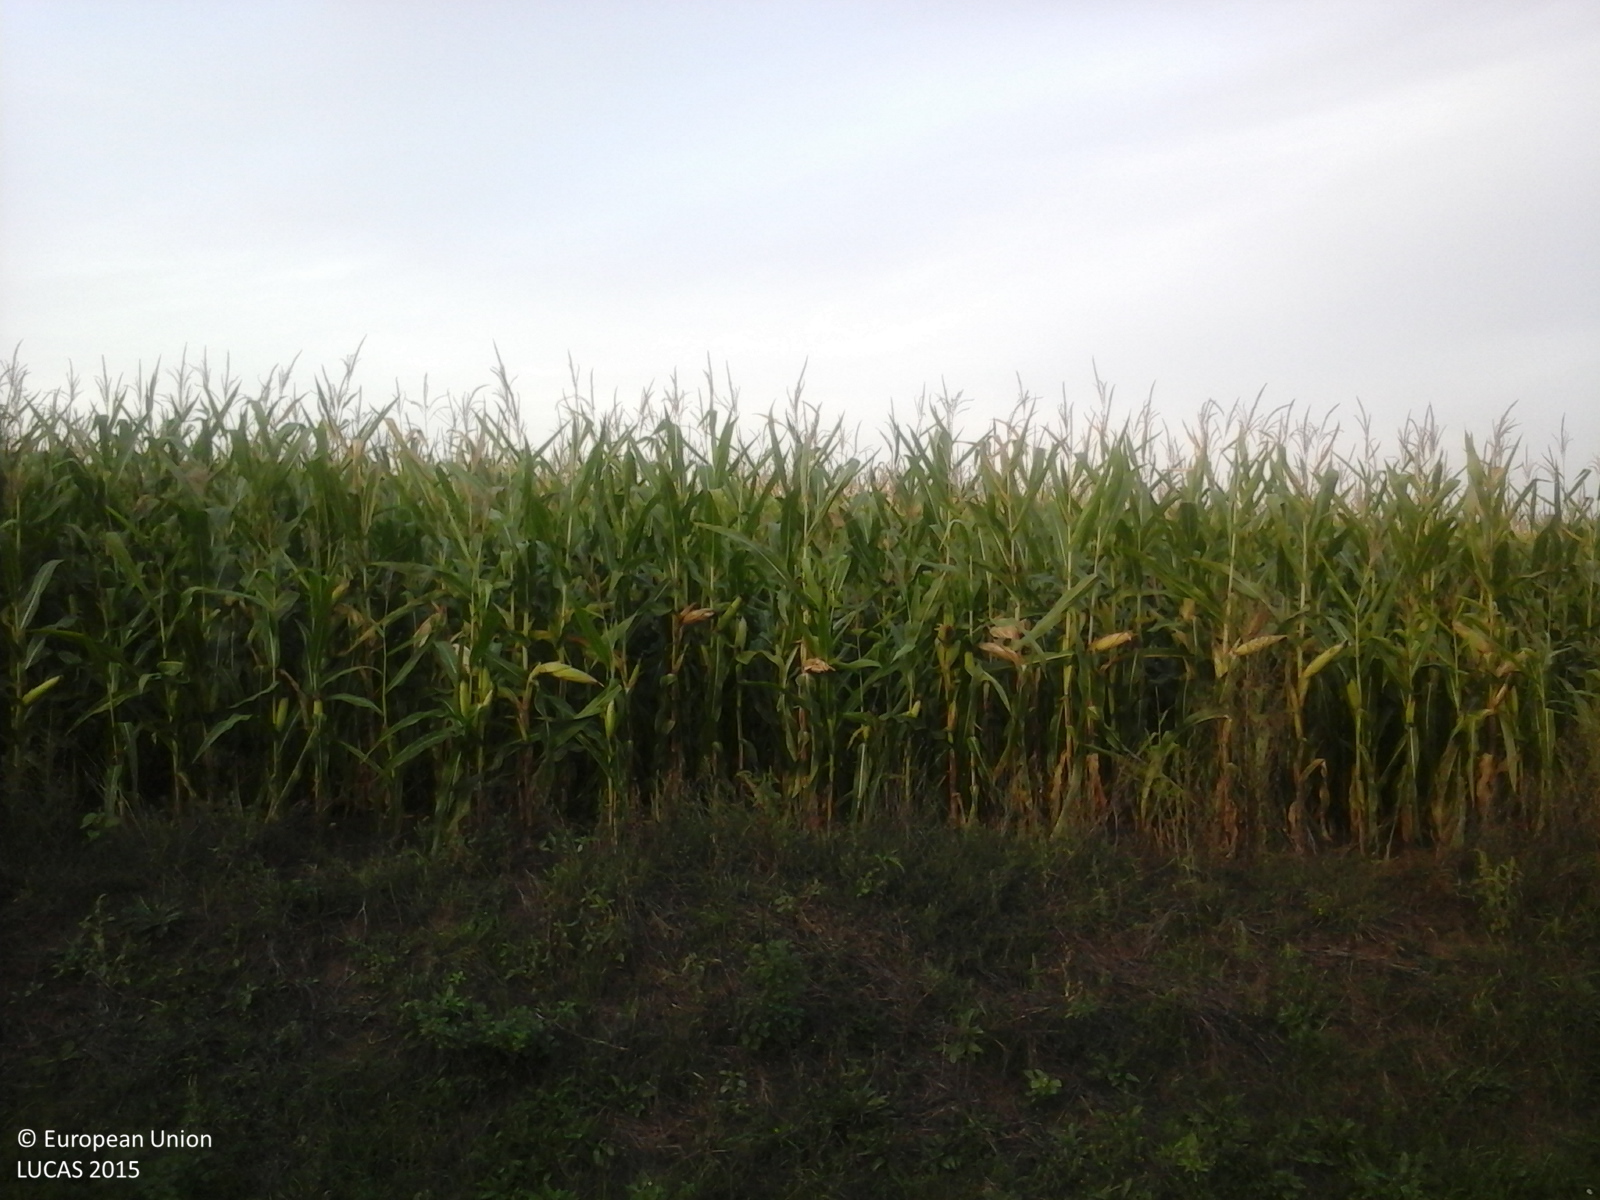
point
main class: Cropland
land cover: Maize
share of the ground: > 75 %
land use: Agriculture (excluding fallow land and kitchen gardens)
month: September
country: RO
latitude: 46.7346
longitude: 24.0426
